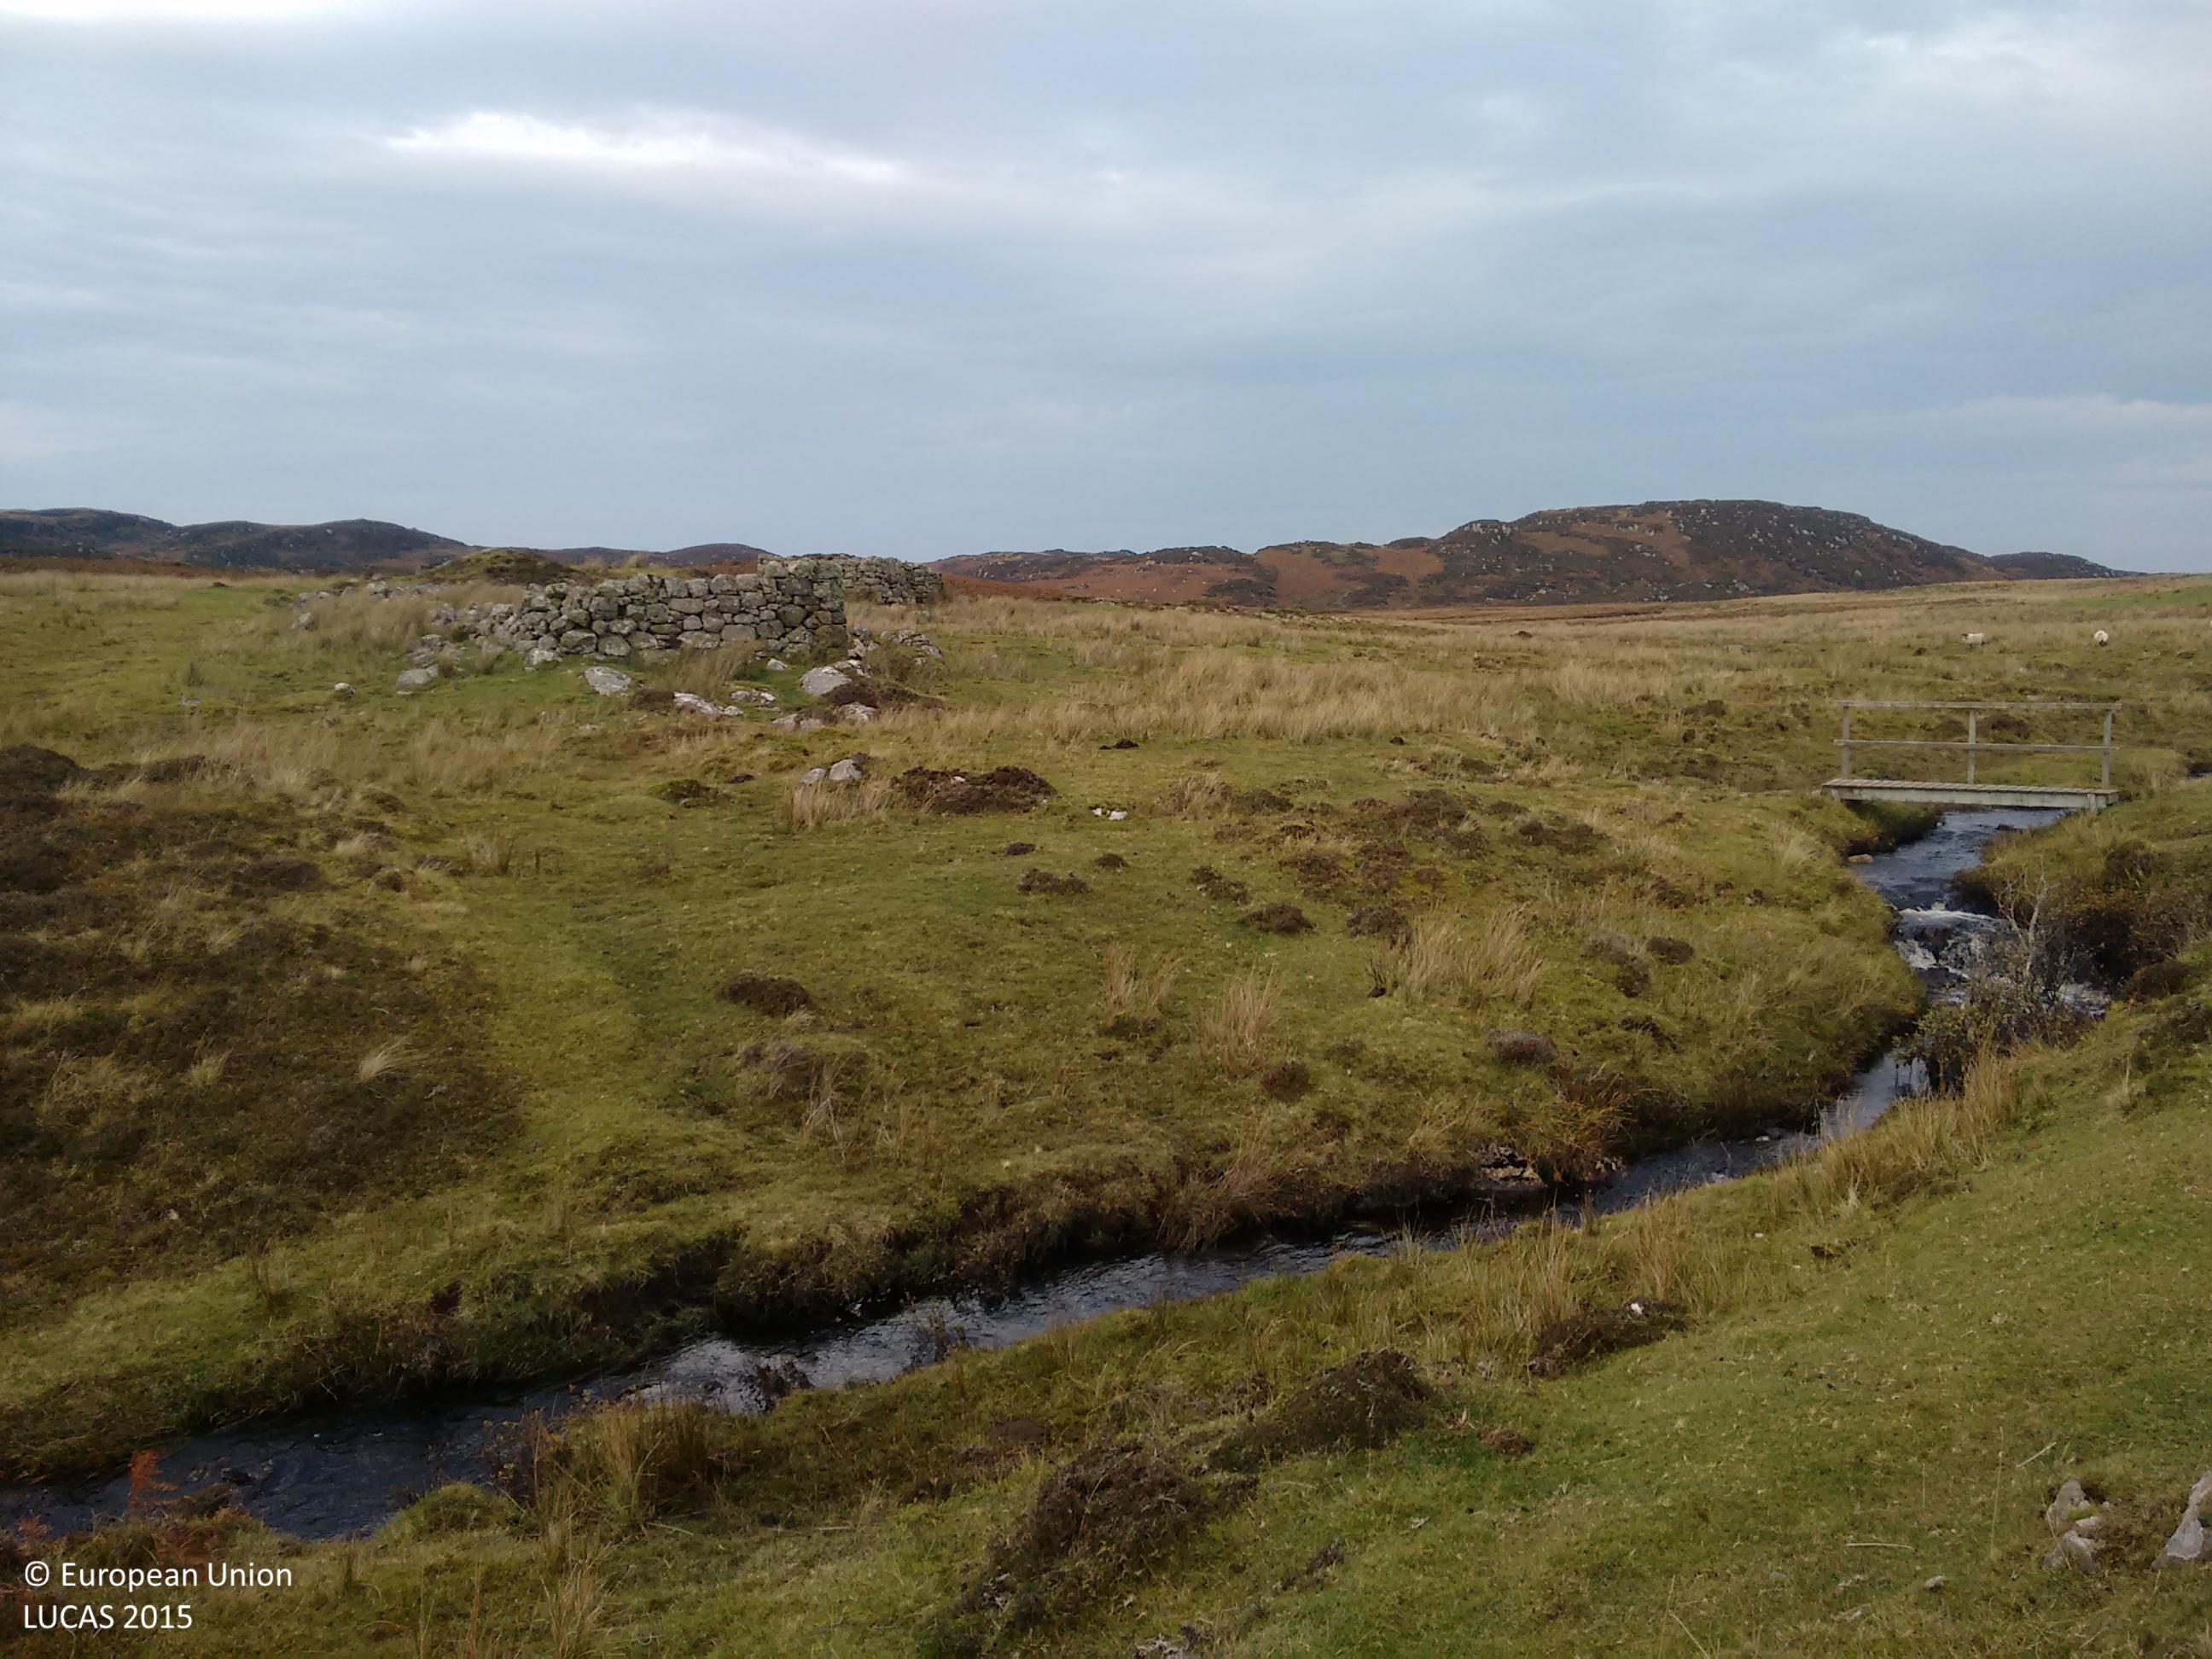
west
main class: Grassland
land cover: Grassland without tree/shrub cover
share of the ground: > 75 %
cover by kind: herbaceous plants 90 %, lichens and mosses 10 %
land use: Agriculture (excluding fallow land and kitchen gardens)
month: October
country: GB
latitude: 56.2996
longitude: -6.2533
